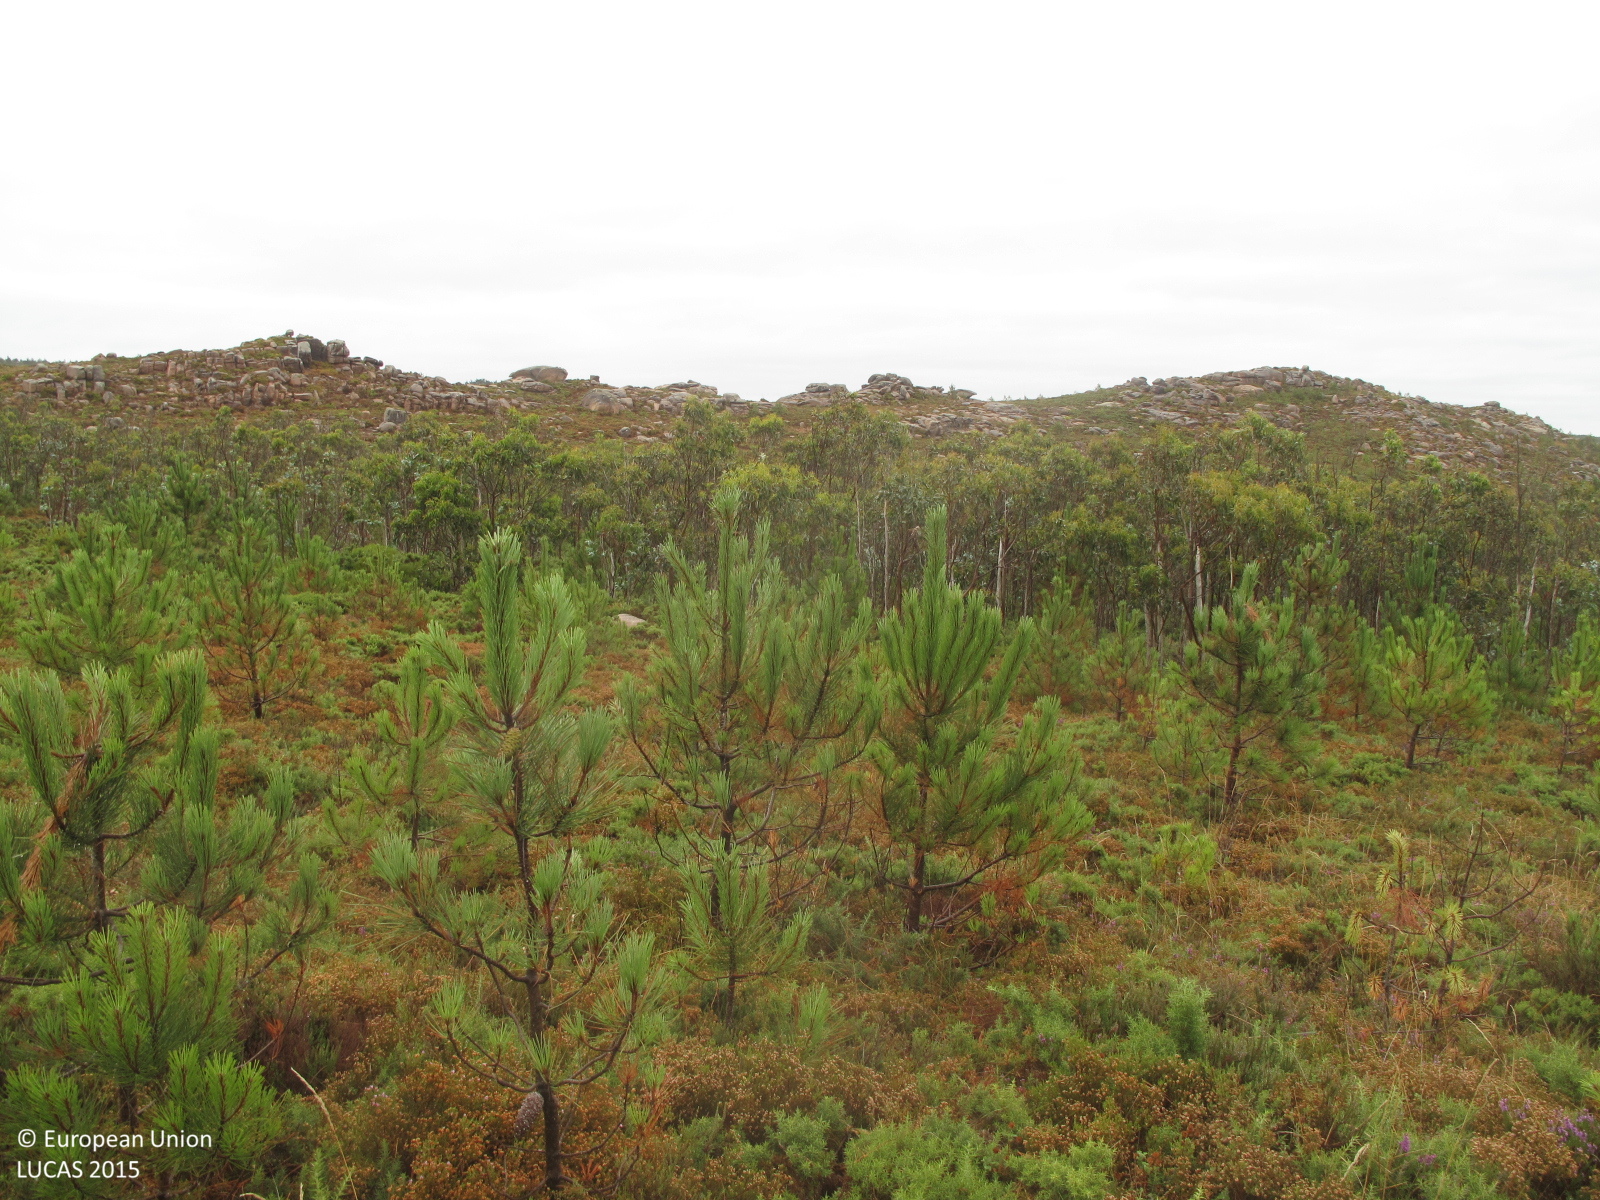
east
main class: Woodland
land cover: Pine dominated coniferous woodland
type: exotic forest
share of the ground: 10 - 25 %
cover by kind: shrubs 70 %, coniferous forest trees 20 %, consolidated bare surface 10 %
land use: Forestry
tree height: < 5 m
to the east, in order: Pine dominated coniferous woodland; Dry stone walls; Other mixed woodland; Rock outcrops; Other mixed woodland; Rock outcrops; Shrubland without tree cover; Rock outcrops; Rocks and stones; Shrubland without tree cover
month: July
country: ES
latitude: 43.1735
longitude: -9.1592
